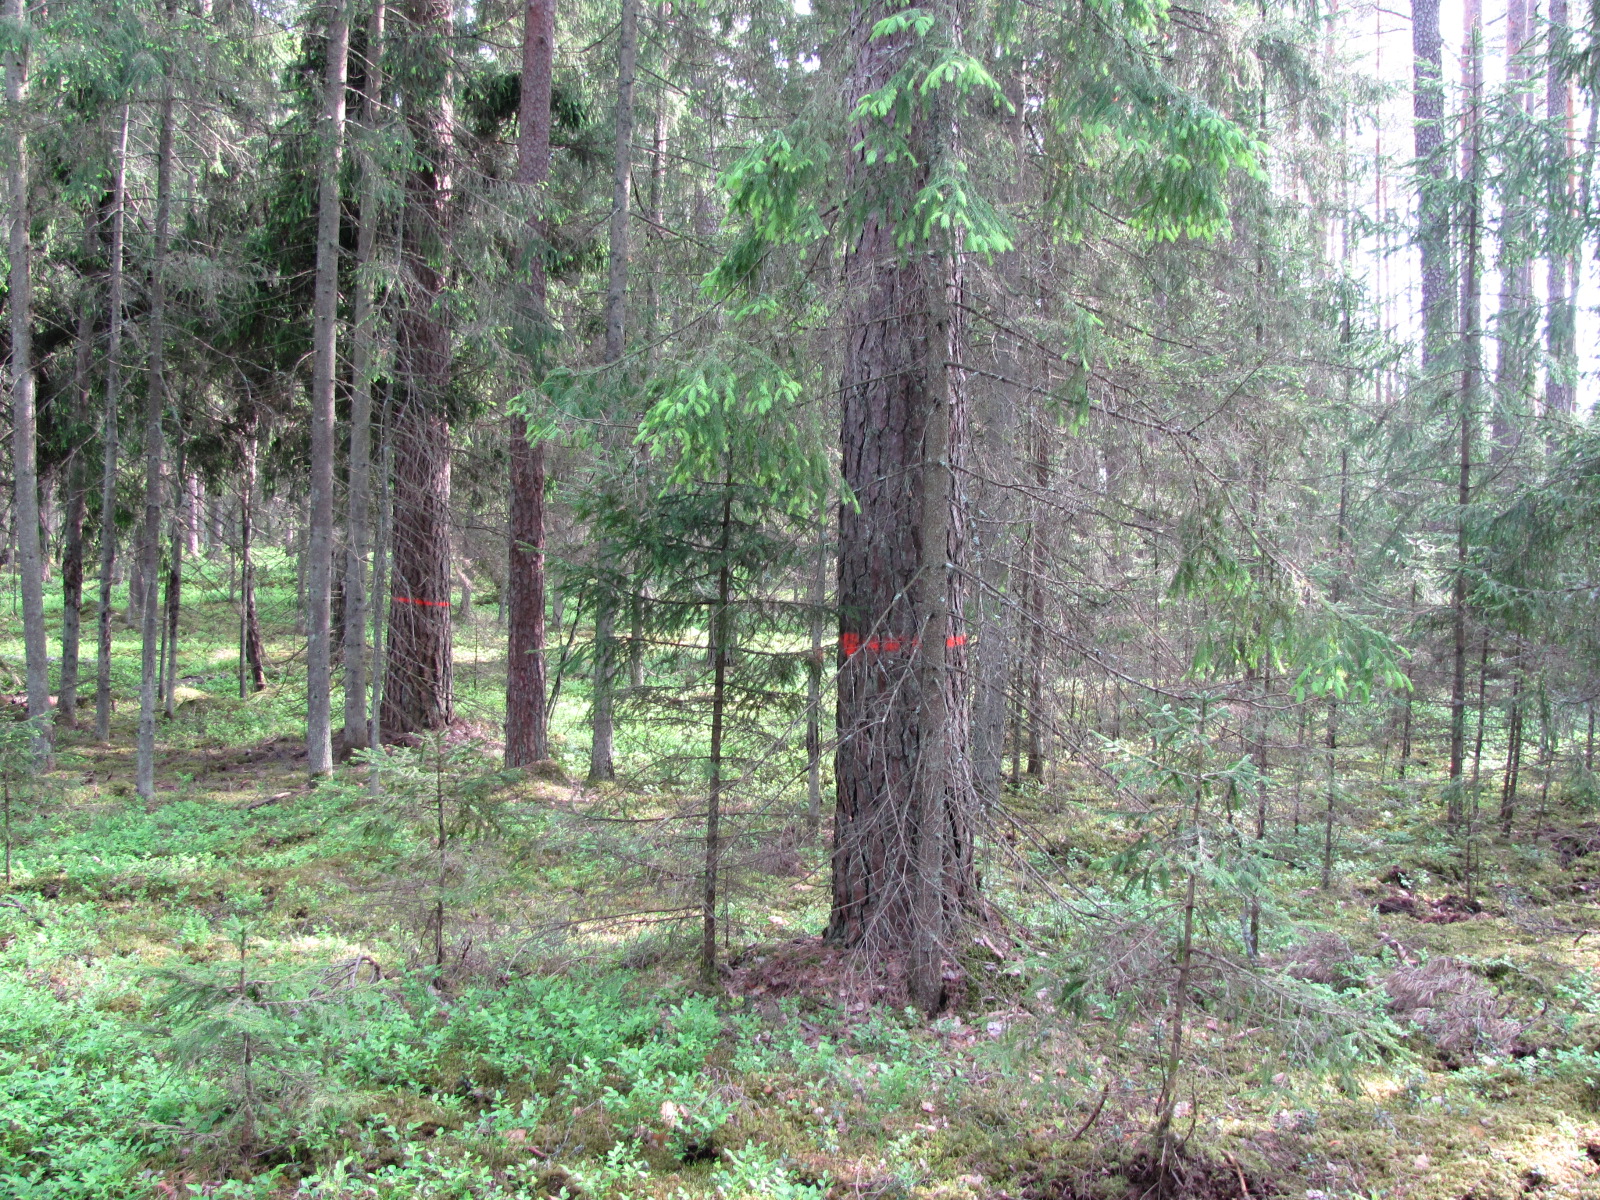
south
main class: Woodland
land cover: Other coniferous woodland
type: hemiboreal forest and nemoral coniferous forest and mixed broadleaved-coniferous forest
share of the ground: > 75 %
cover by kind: coniferous forest trees 90 %, herbaceous plants 5 %, lichens and mosses 5 %
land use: Forestry
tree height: > 5 m
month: June
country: LV
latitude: 56.6371
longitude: 24.3584
